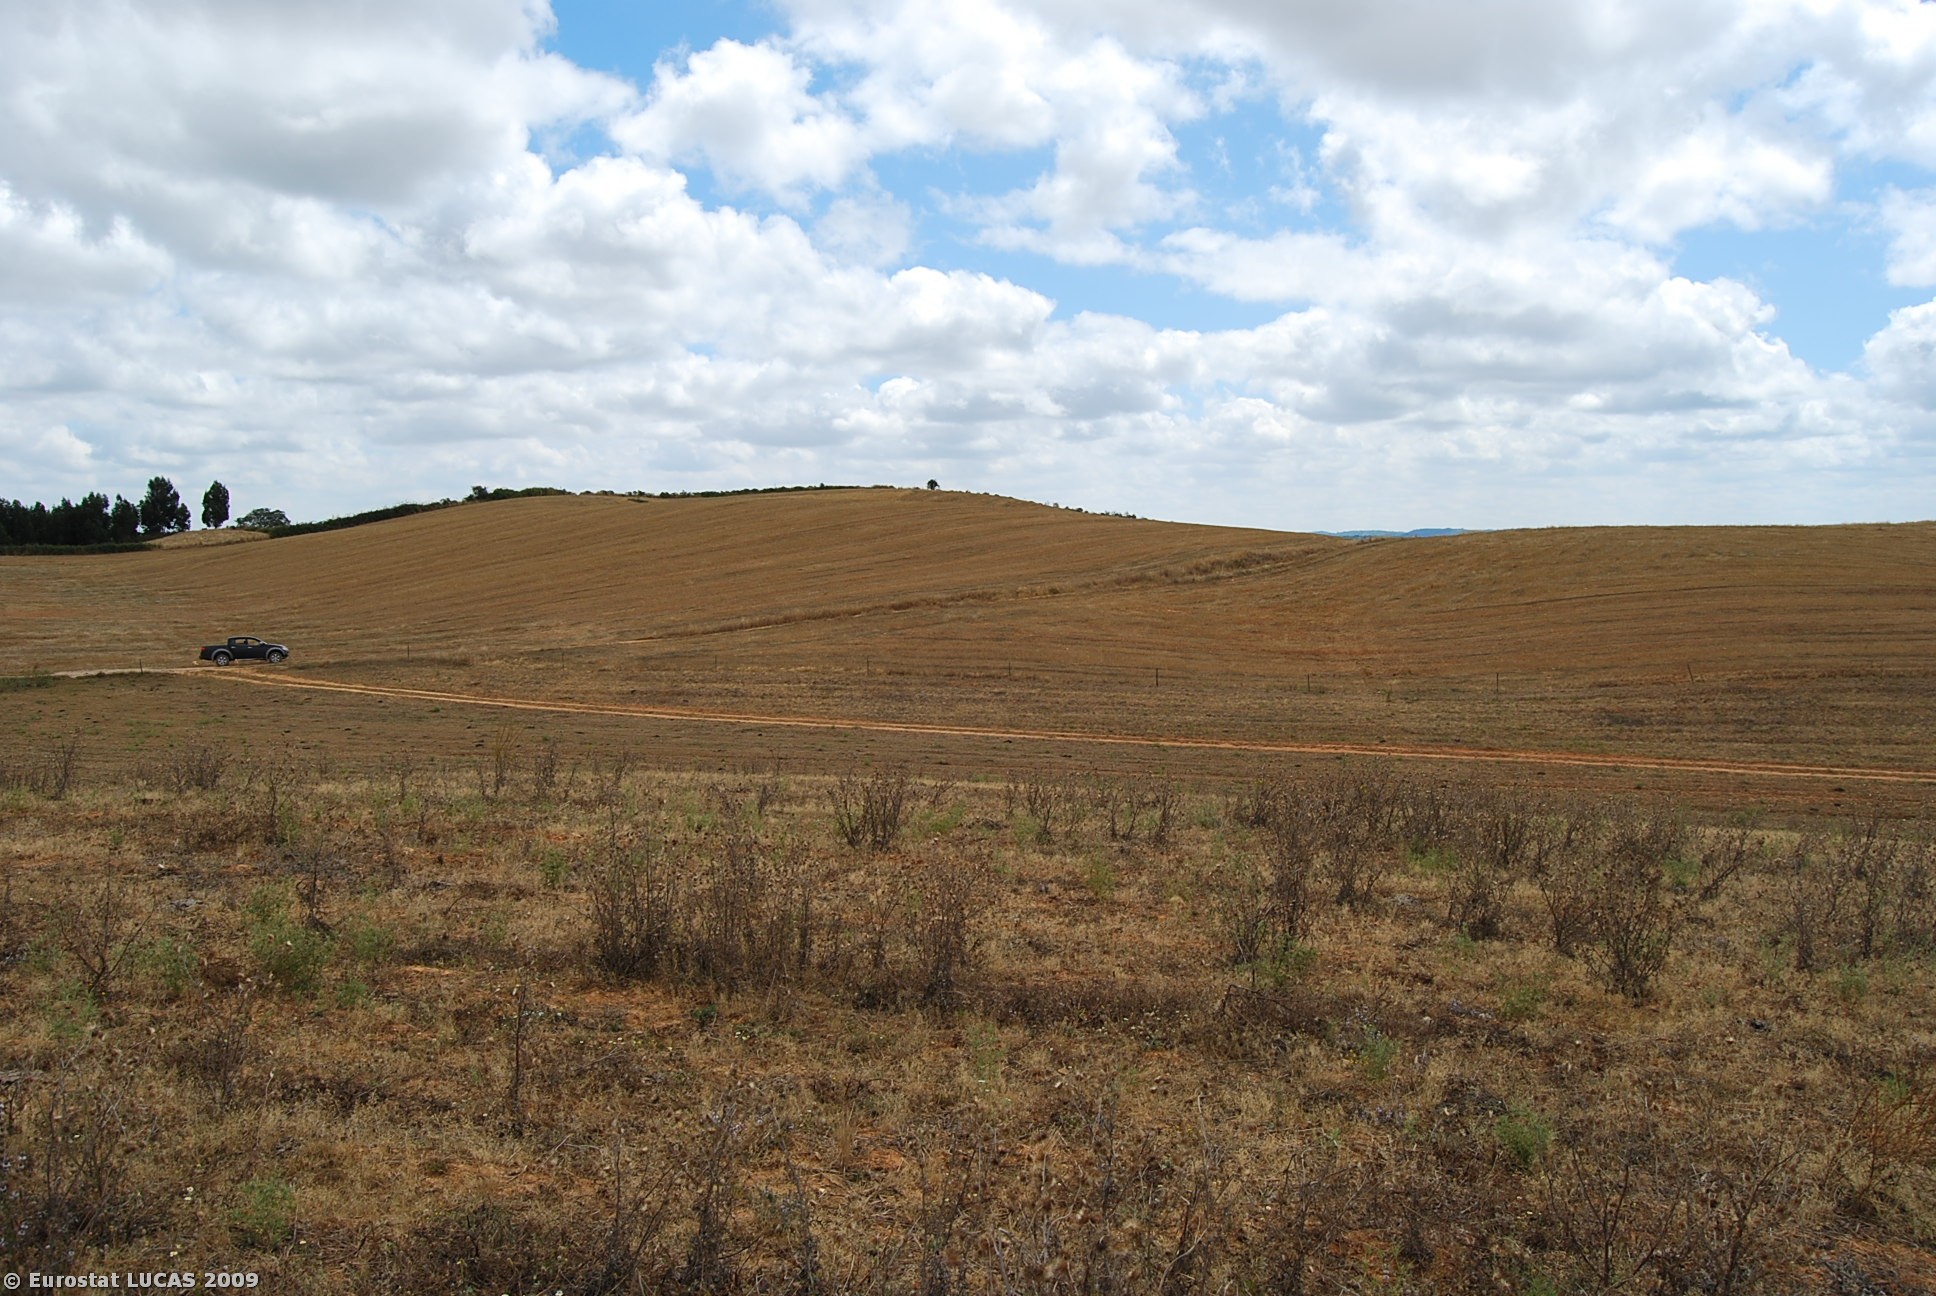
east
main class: Grassland
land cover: Grassland without tree/shrub cover
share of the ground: > 75 %
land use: Agriculture (excluding fallow land and kitchen gardens)
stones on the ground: 10 - 25 %
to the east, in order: Grassland without tree/shrub cover; Fences; Tracks; Durum wheat
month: June
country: PT
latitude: 37.7055
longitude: -8.6309
